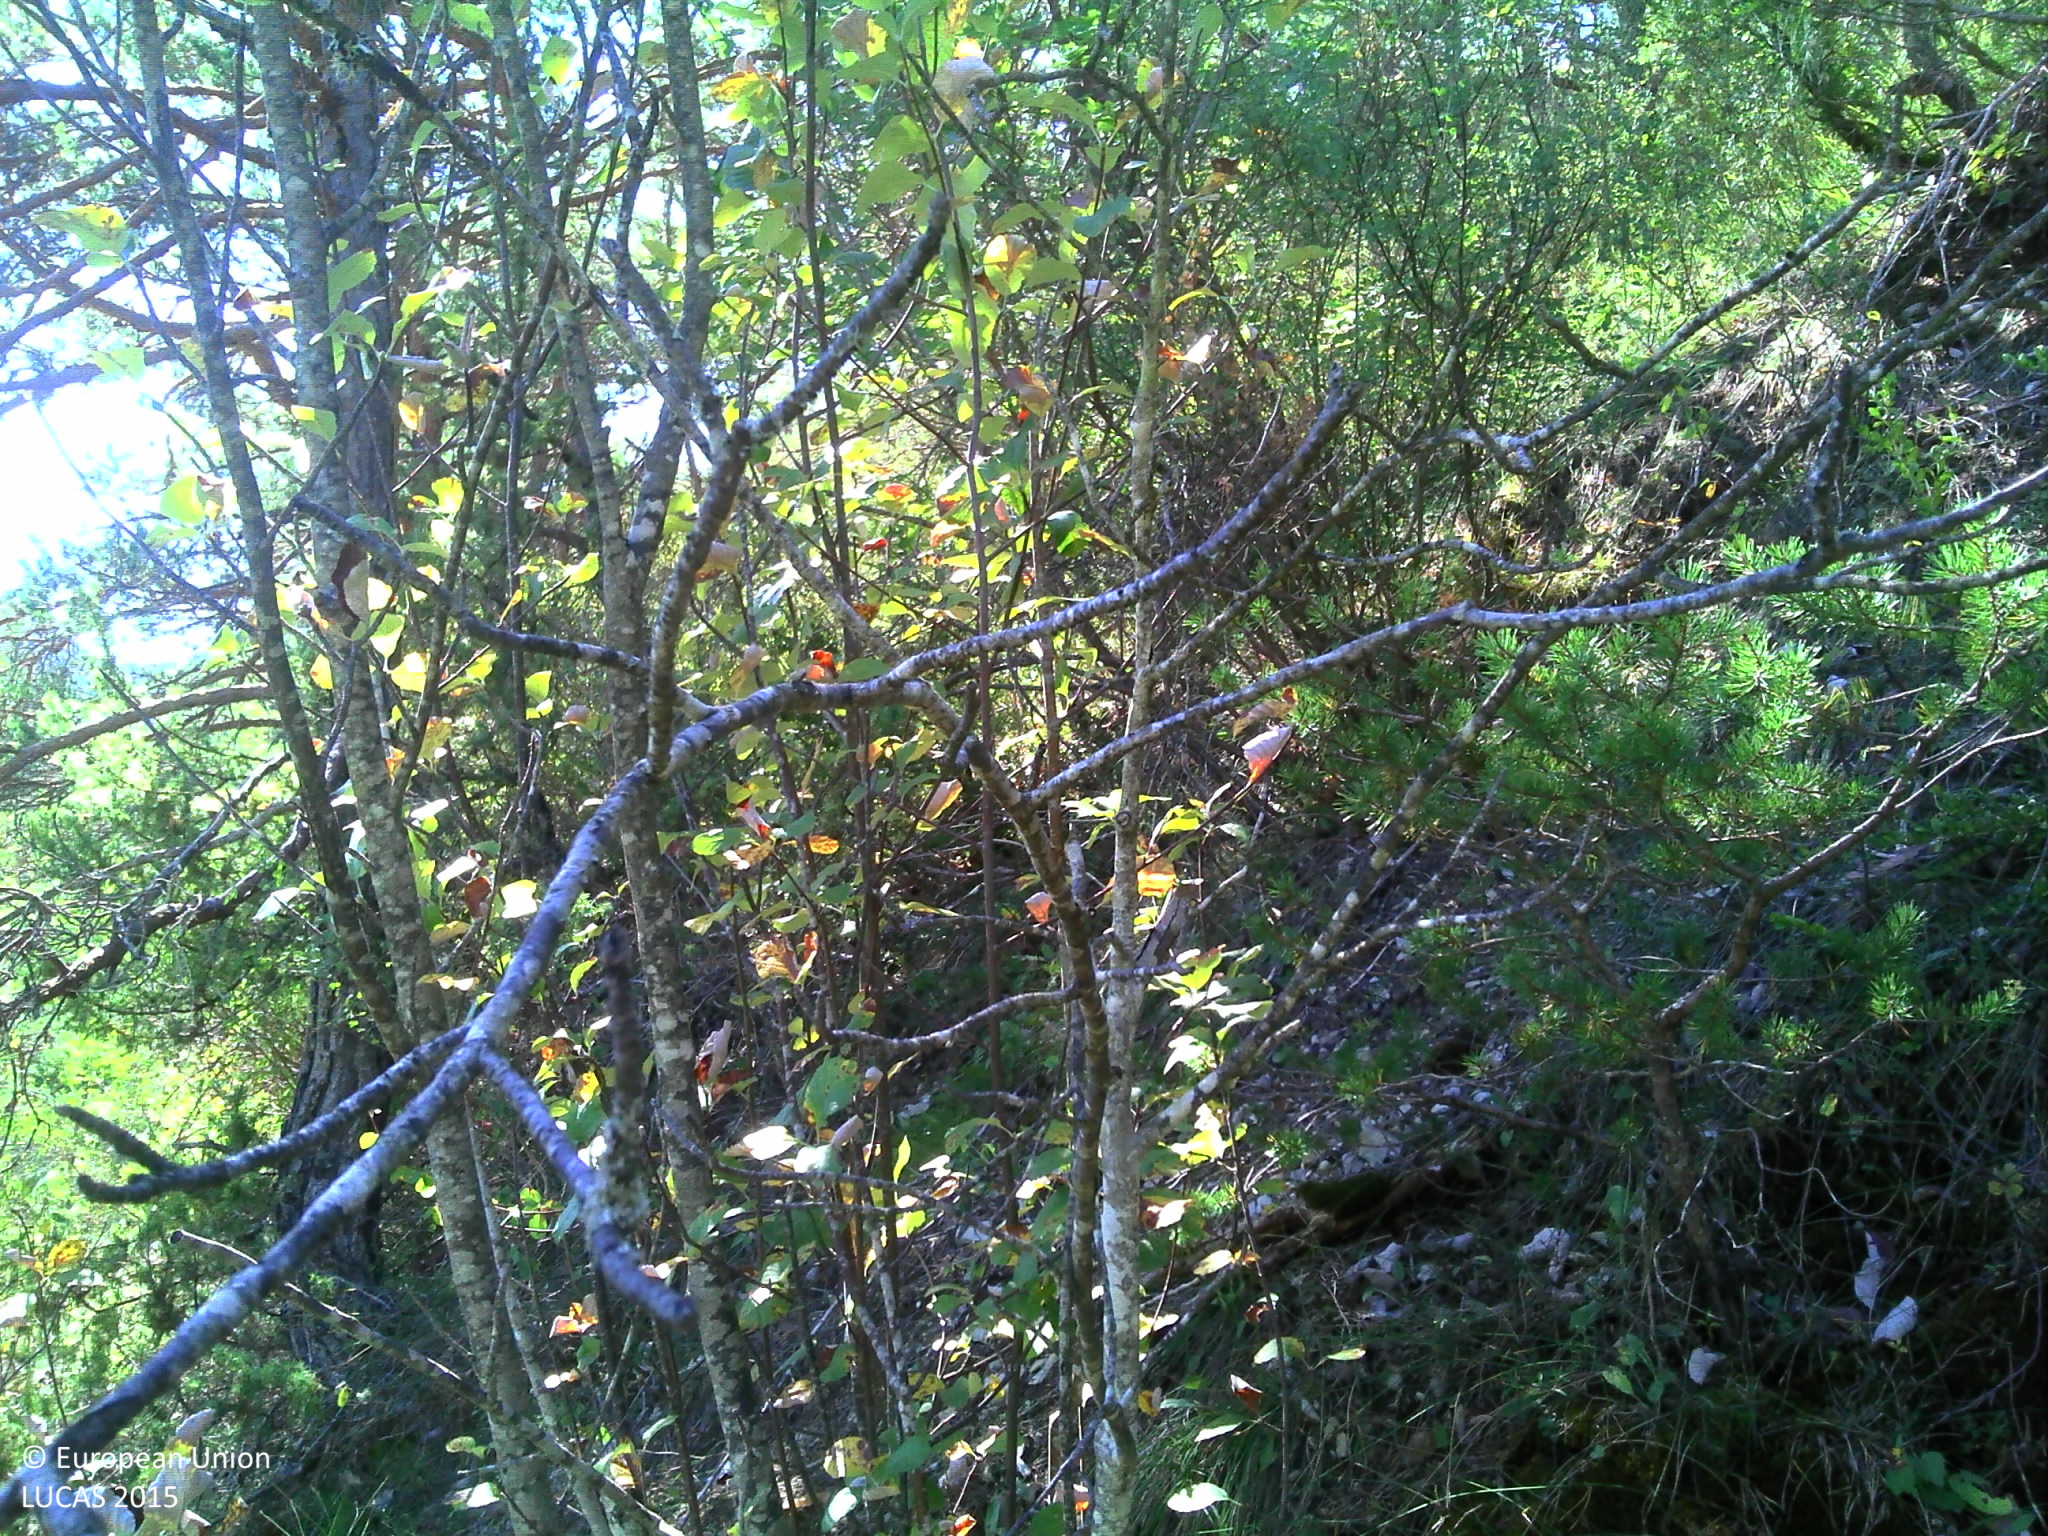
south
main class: Woodland
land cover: Pine dominated coniferous woodland
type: coniferous forest of the mediterranean region
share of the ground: > 75 %
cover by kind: coniferous forest trees 95 %, broadleaved forest trees 5 %
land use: Semi-natural and natural areas not in use
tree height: > 5 m
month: September
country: FR
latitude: 44.3265
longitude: 5.5307
